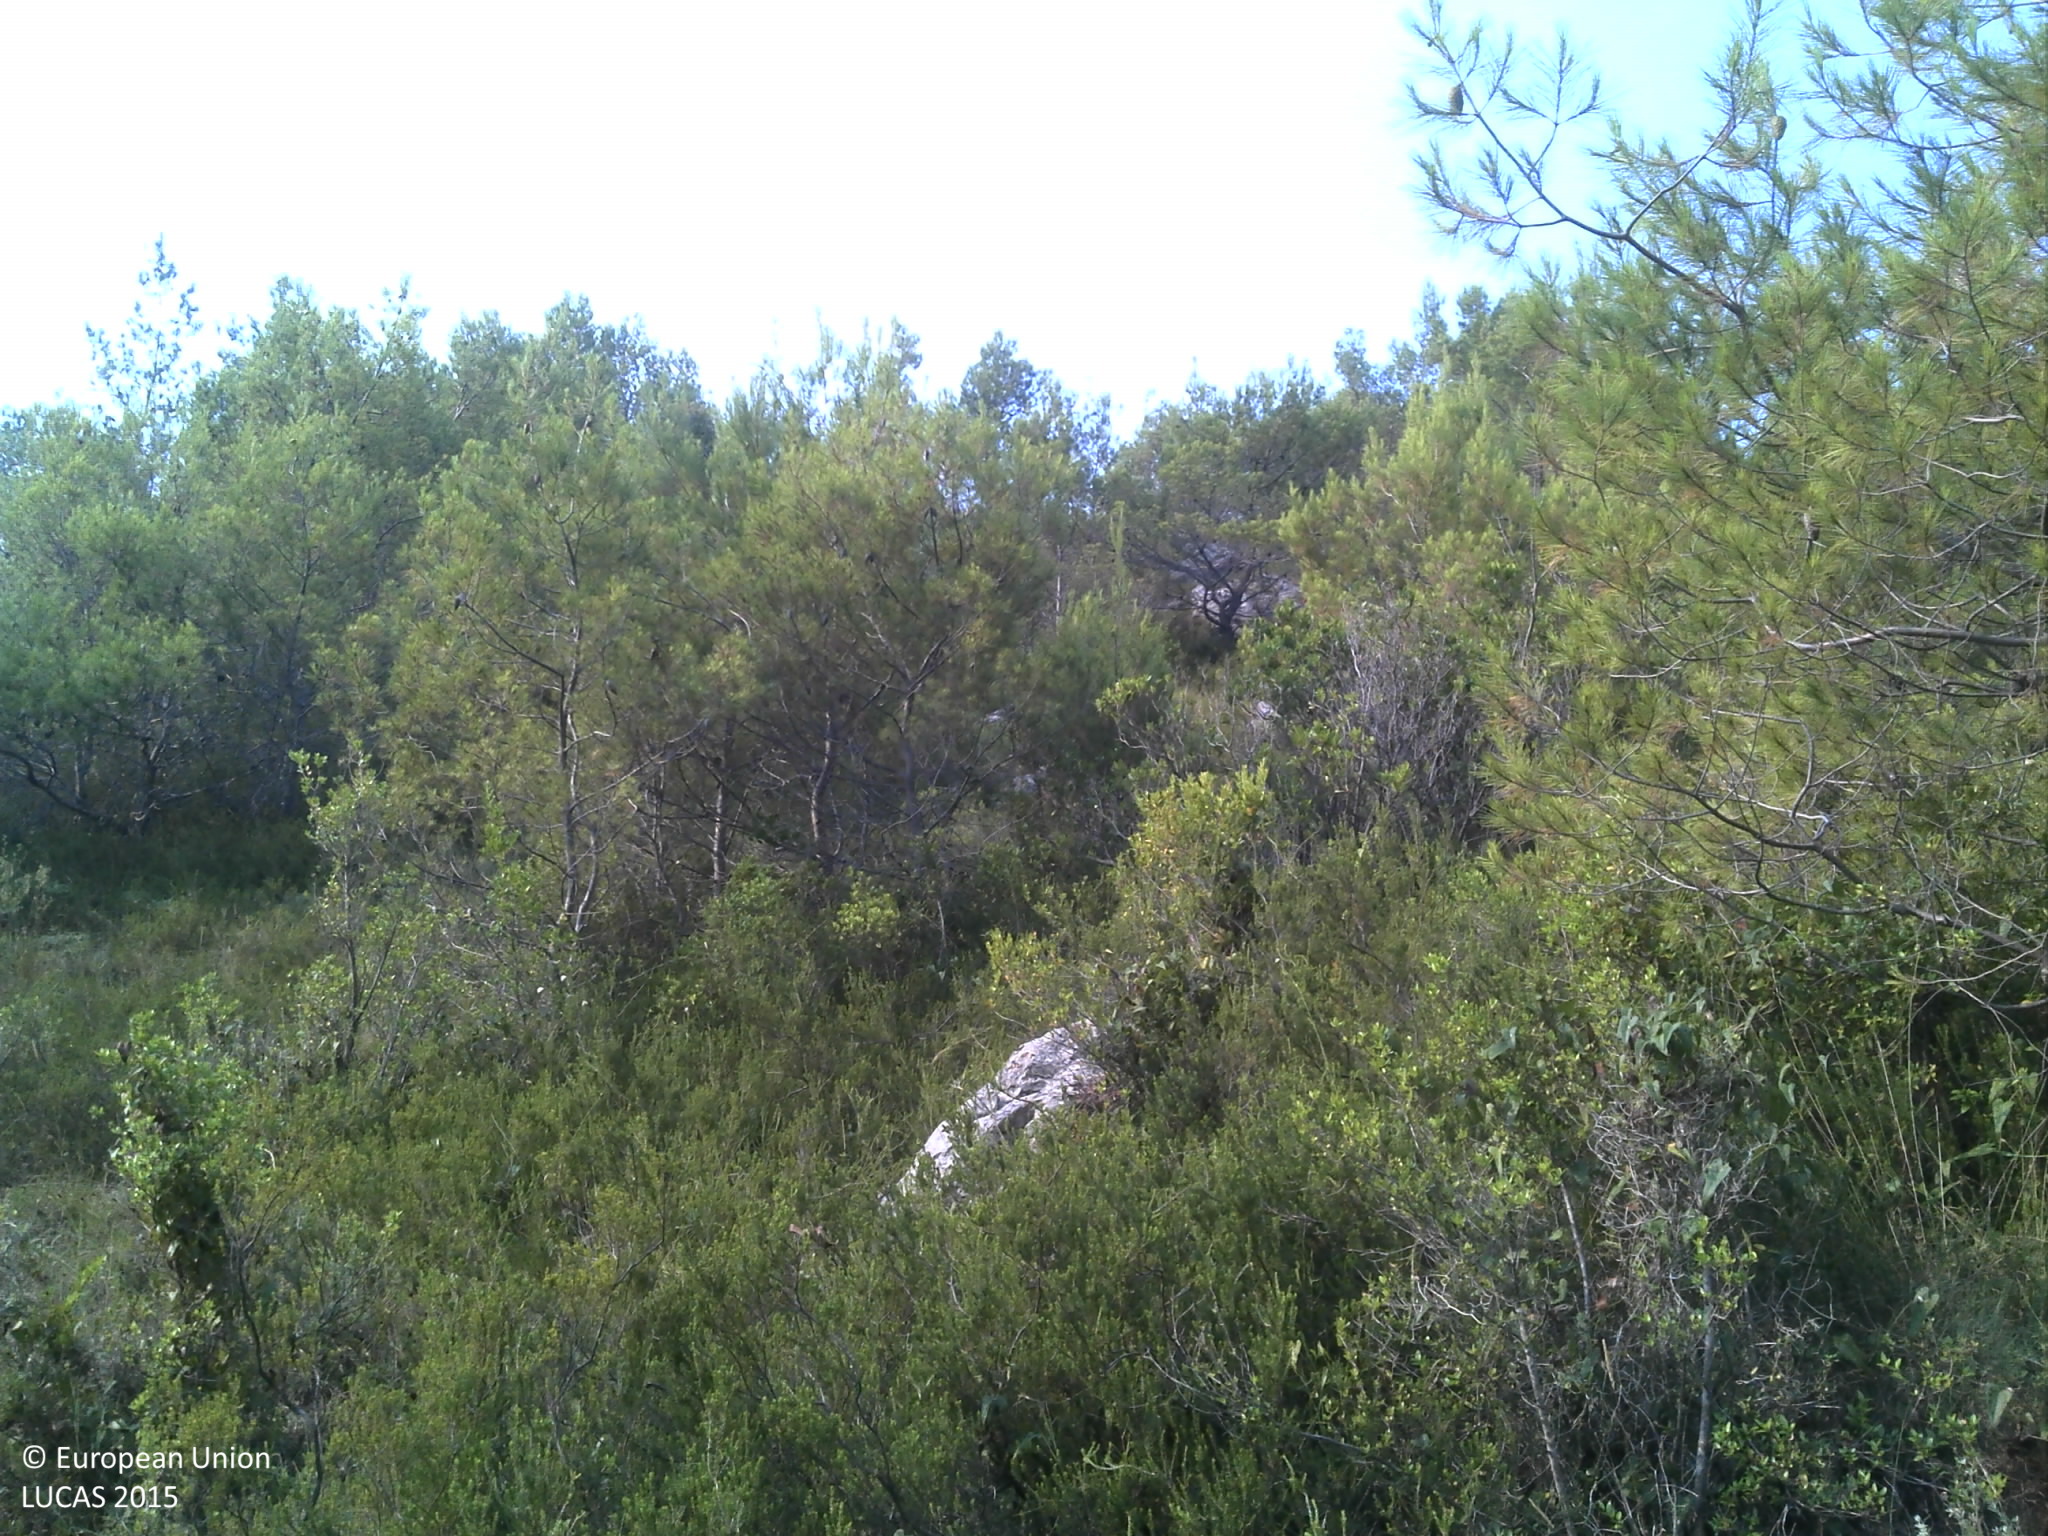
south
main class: Woodland
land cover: Pine dominated coniferous woodland
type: coniferous forest of the mediterranean region
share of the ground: > 75 %
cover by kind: coniferous forest trees 60 %, shrubs 20 %, consolidated bare surface 10 %, unconsolidated bare surface 10 %
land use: Semi-natural and natural areas not in use
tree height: > 5 m
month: July
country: HR
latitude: 42.8134
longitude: 17.7070
